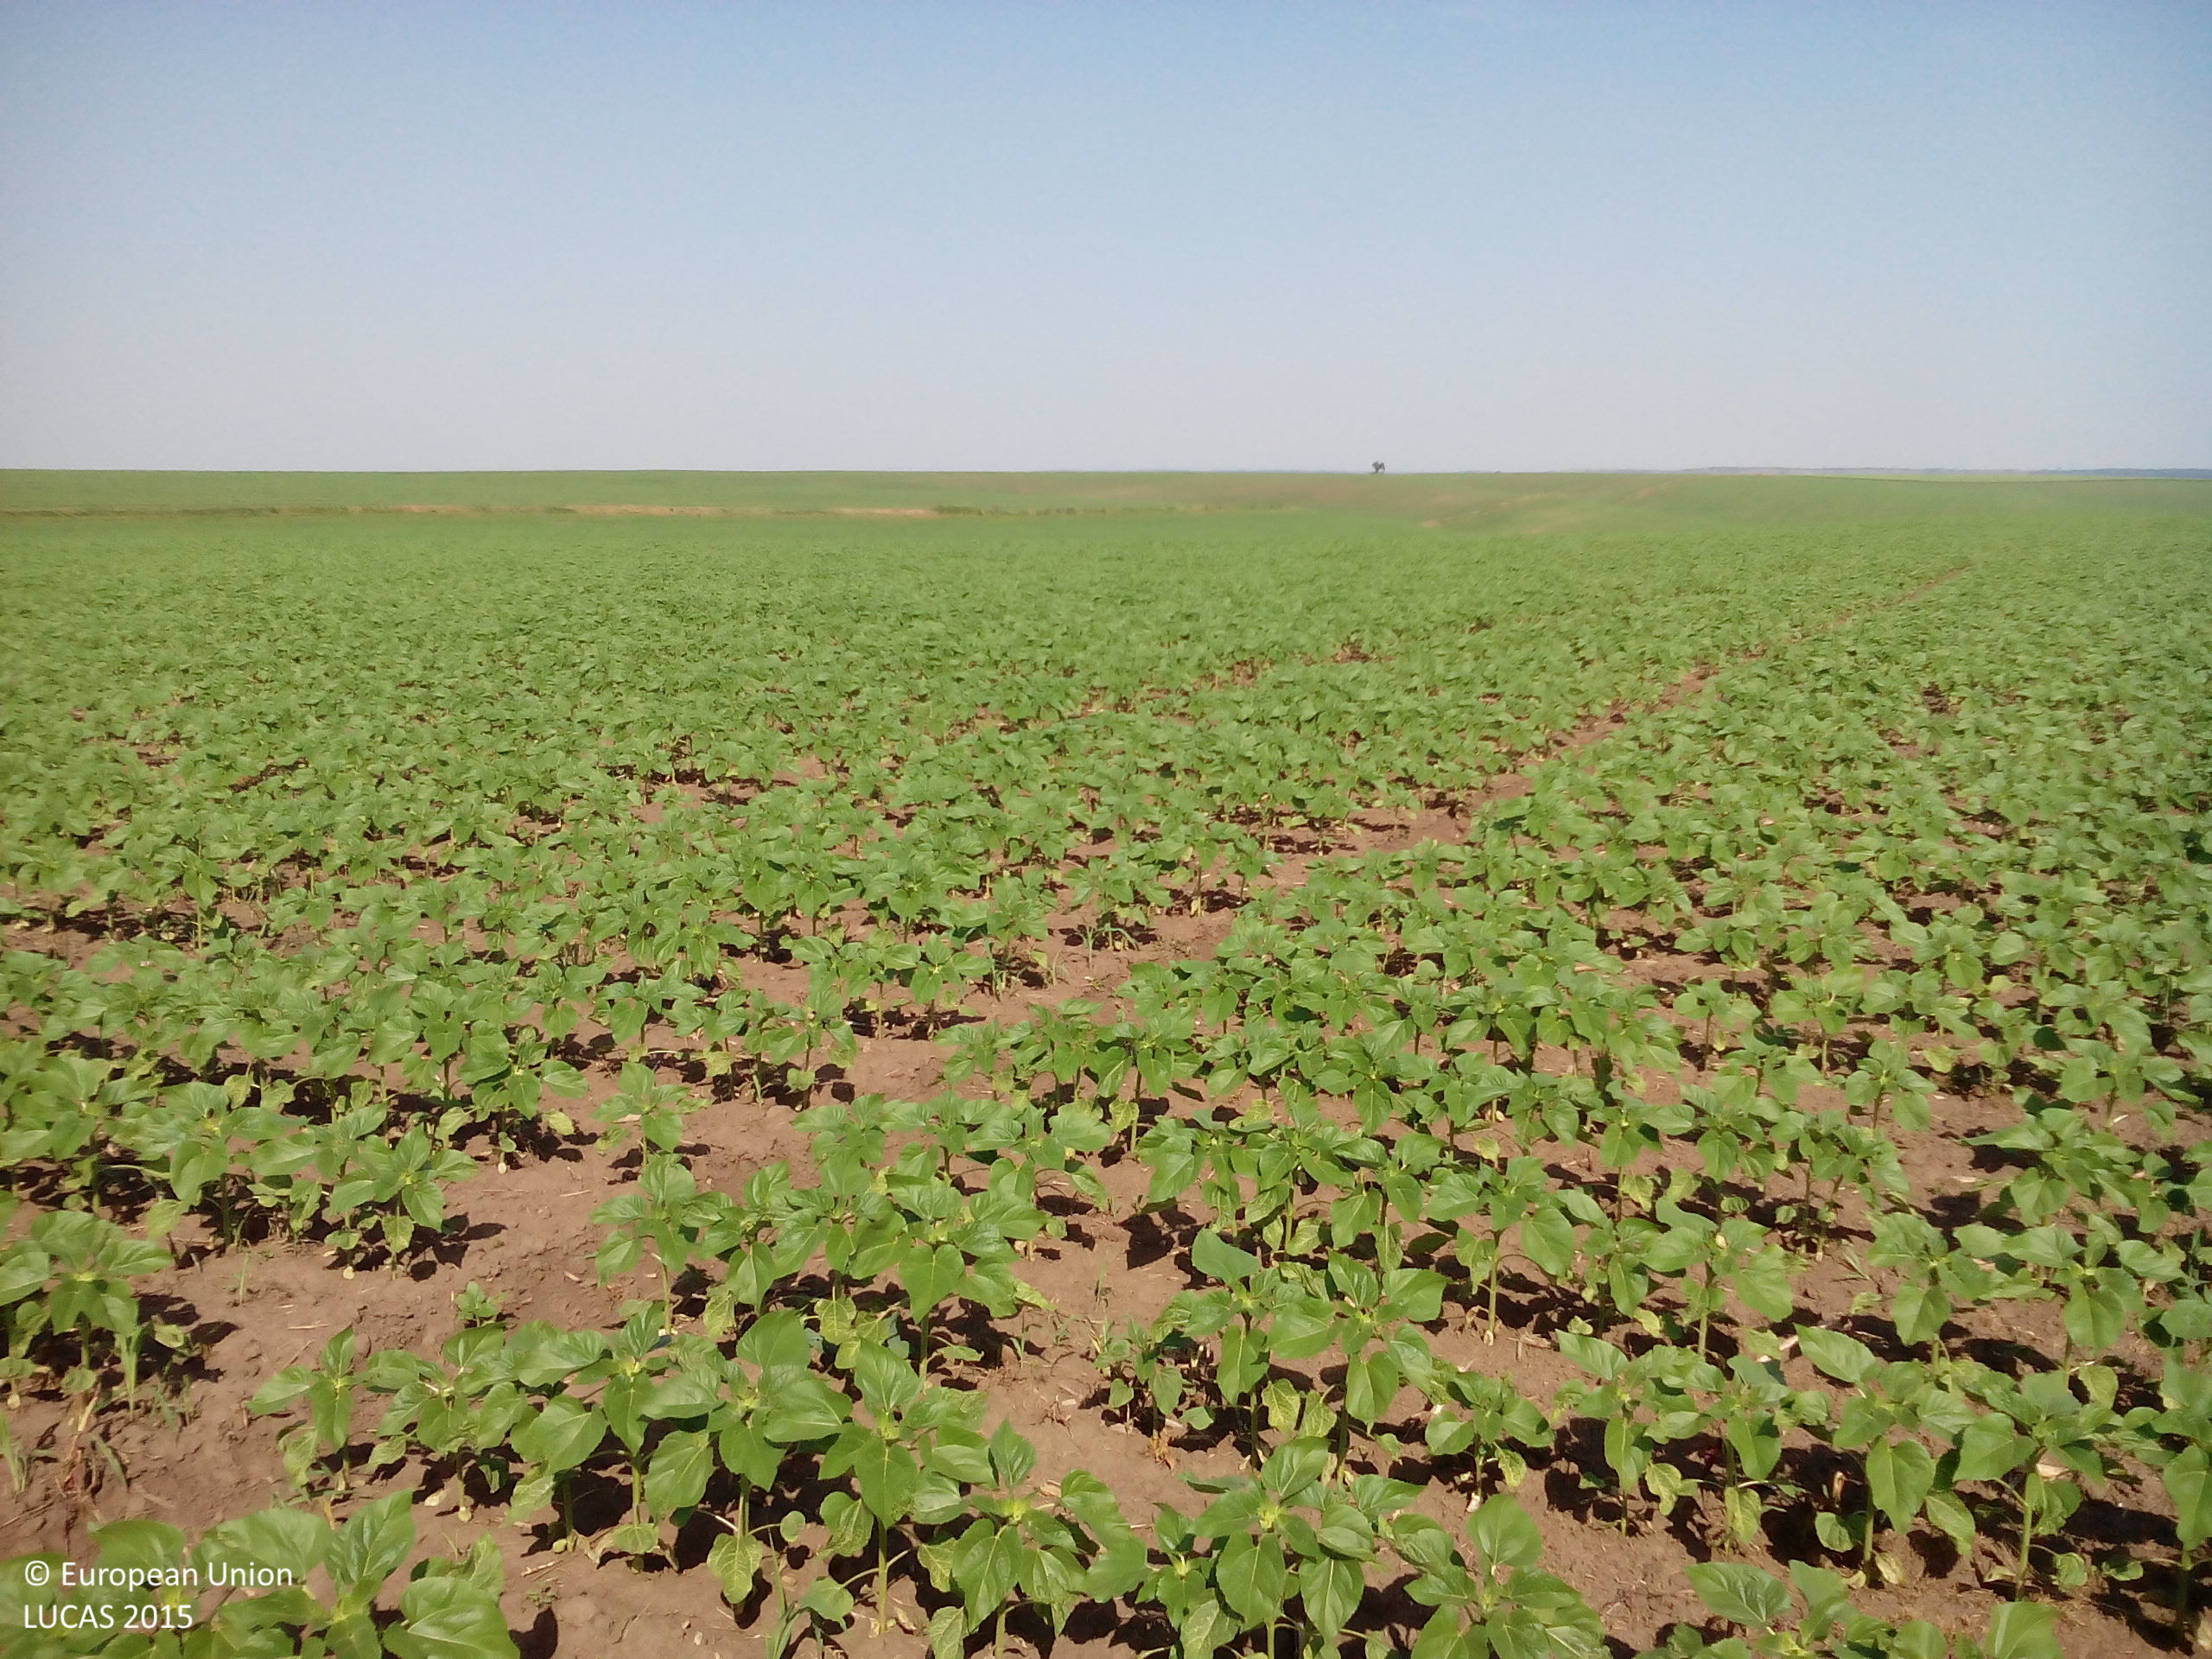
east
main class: Cropland
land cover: Sunflower
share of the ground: 50 - 75 %
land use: Agriculture (excluding fallow land and kitchen gardens)
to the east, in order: Sunflower
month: May
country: BG
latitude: 43.6498
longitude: 24.2798
